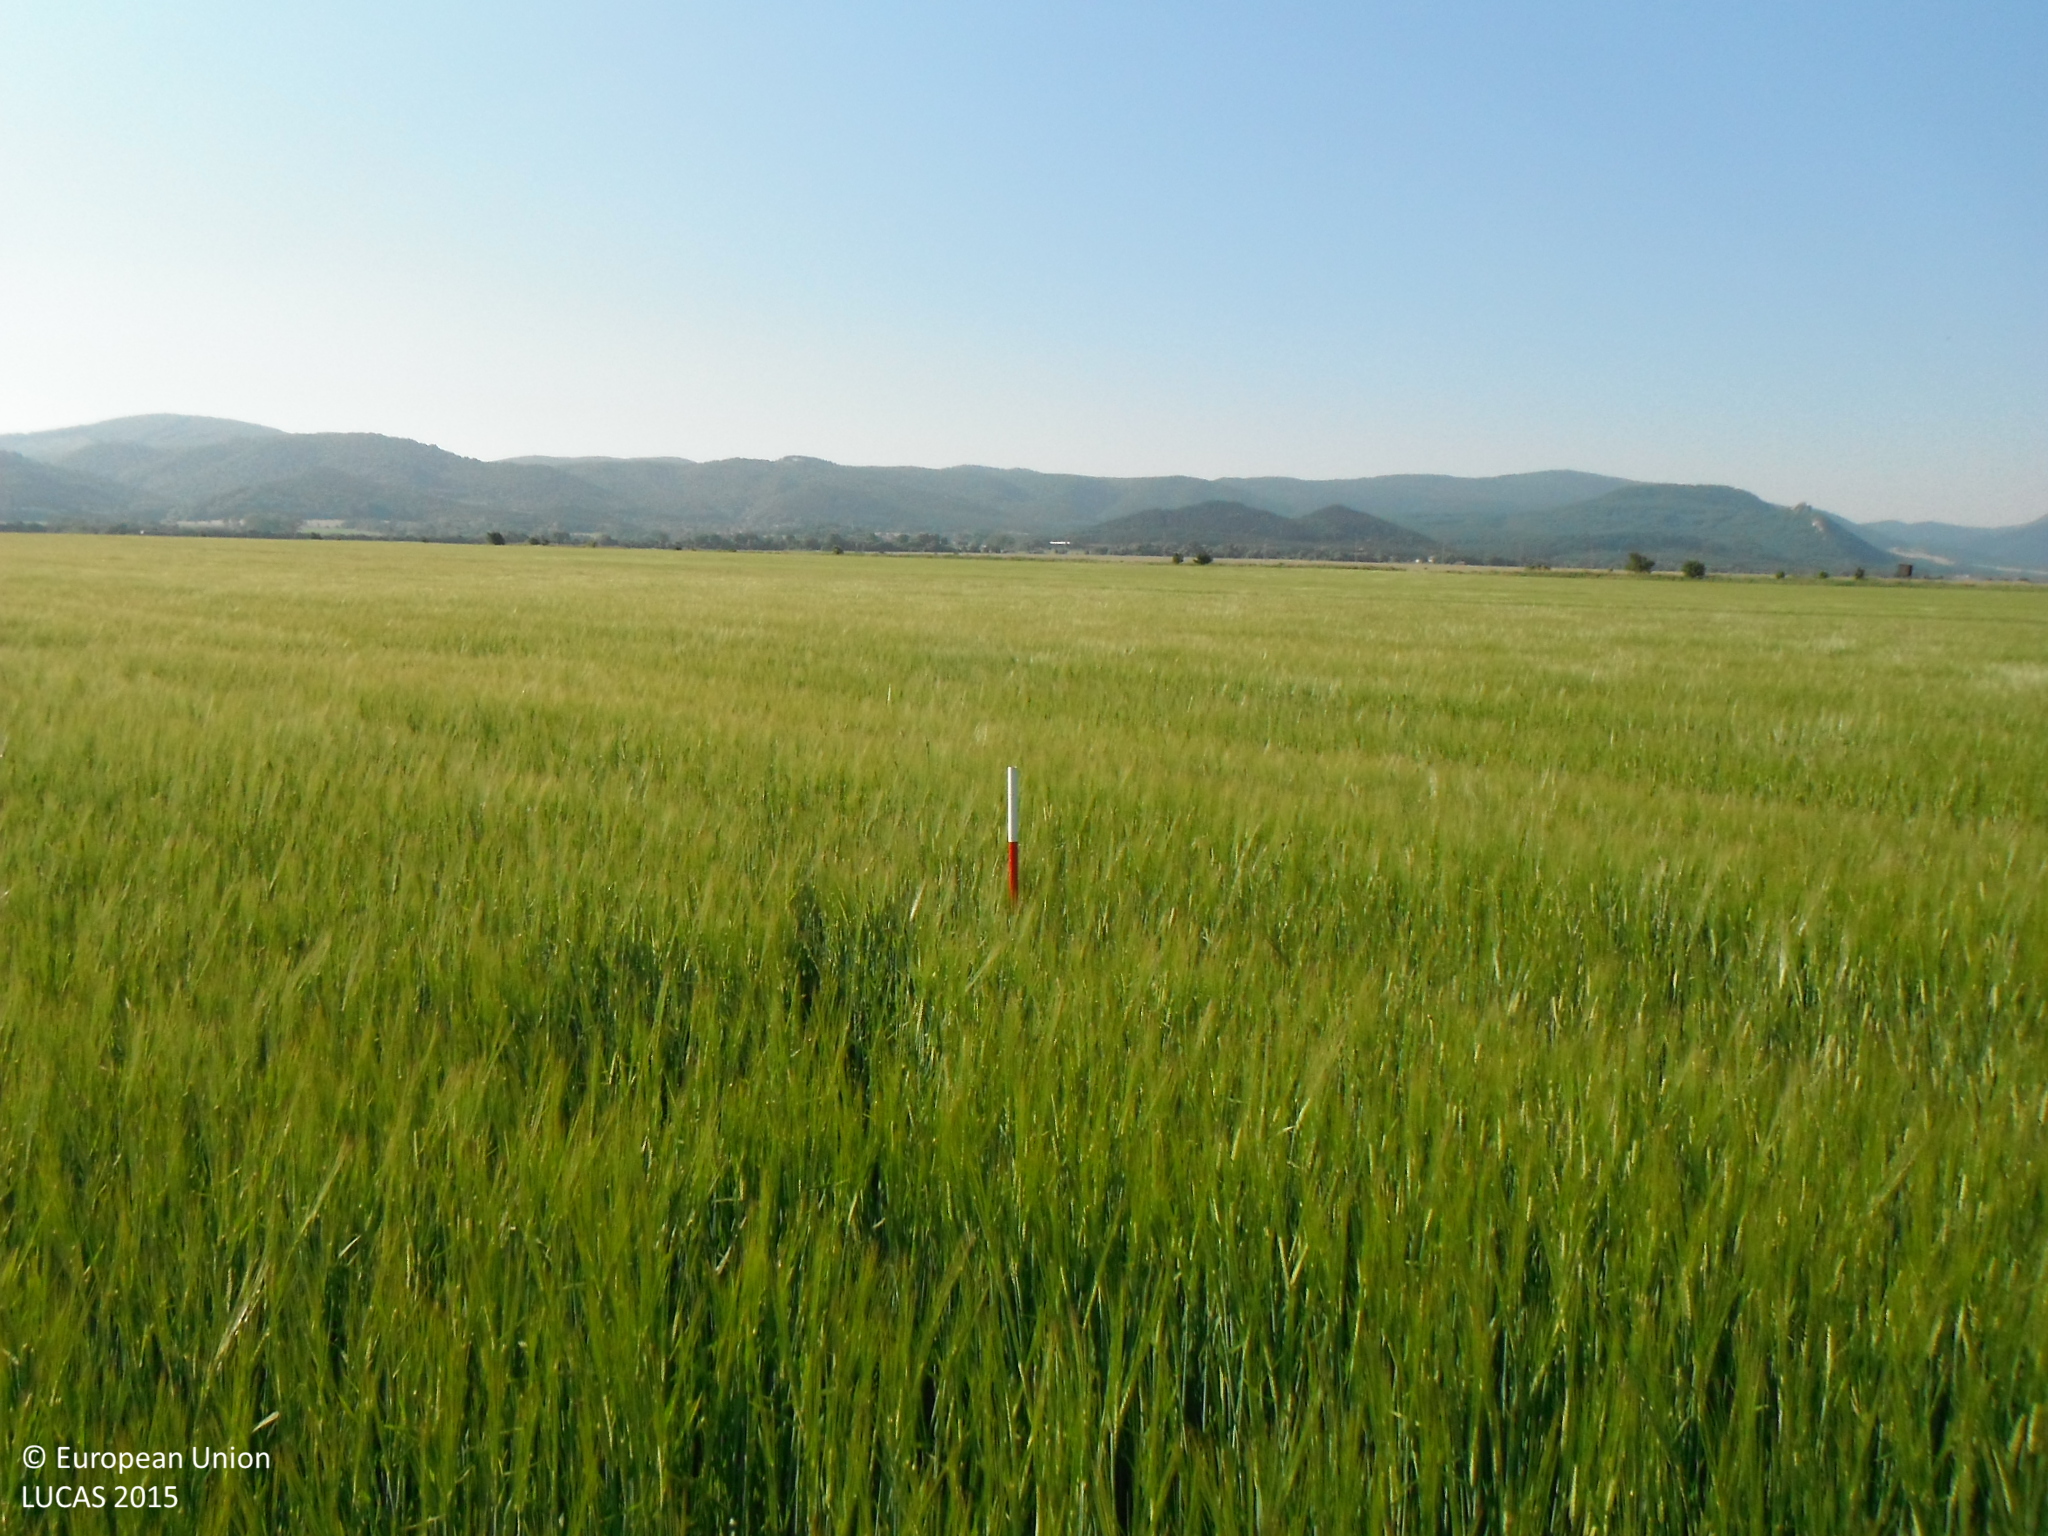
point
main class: Cropland
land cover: Barley
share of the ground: > 75 %
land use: Agriculture (excluding fallow land and kitchen gardens)
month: June
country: SK
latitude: 48.5425
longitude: 17.2833
